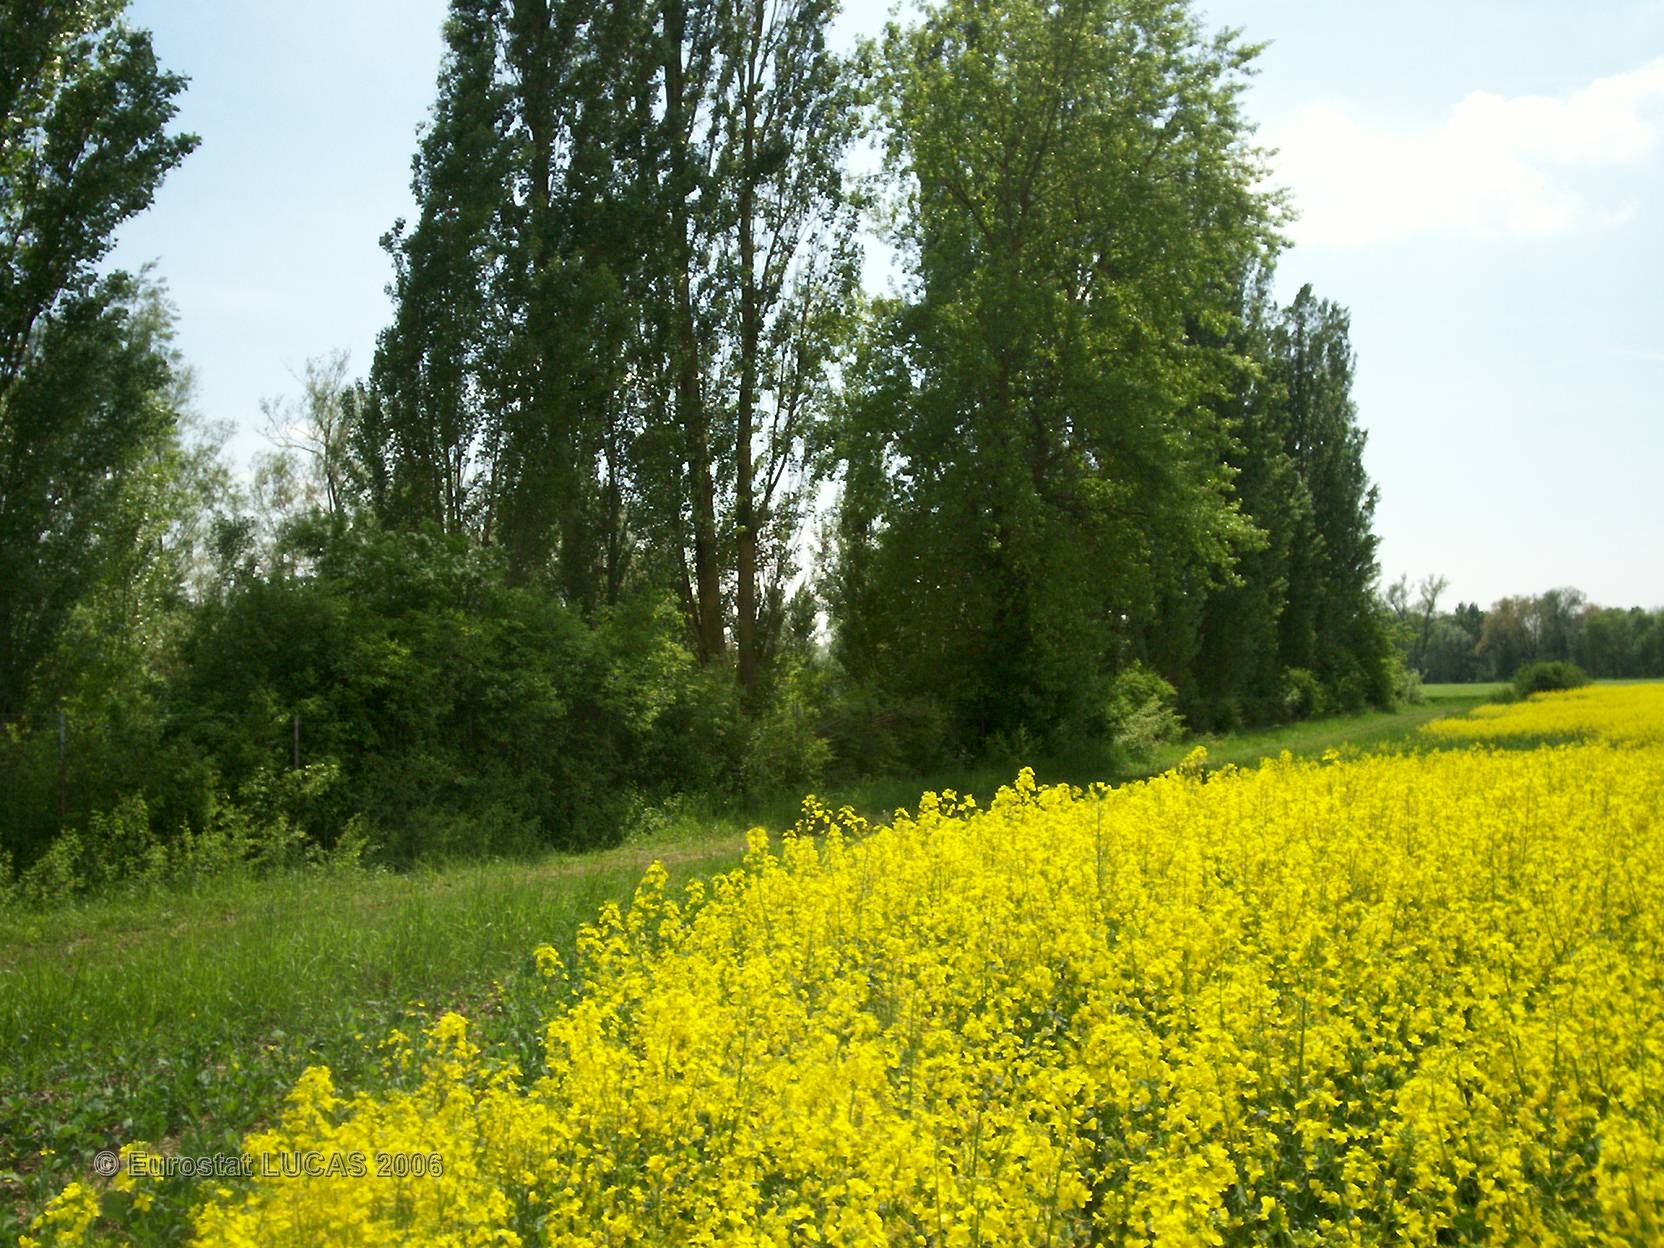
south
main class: Cropland
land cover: Rape and turnip rape
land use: Agriculture (excluding fallow land and kitchen gardens)
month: May
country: FR
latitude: 48.9116
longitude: 4.4158
